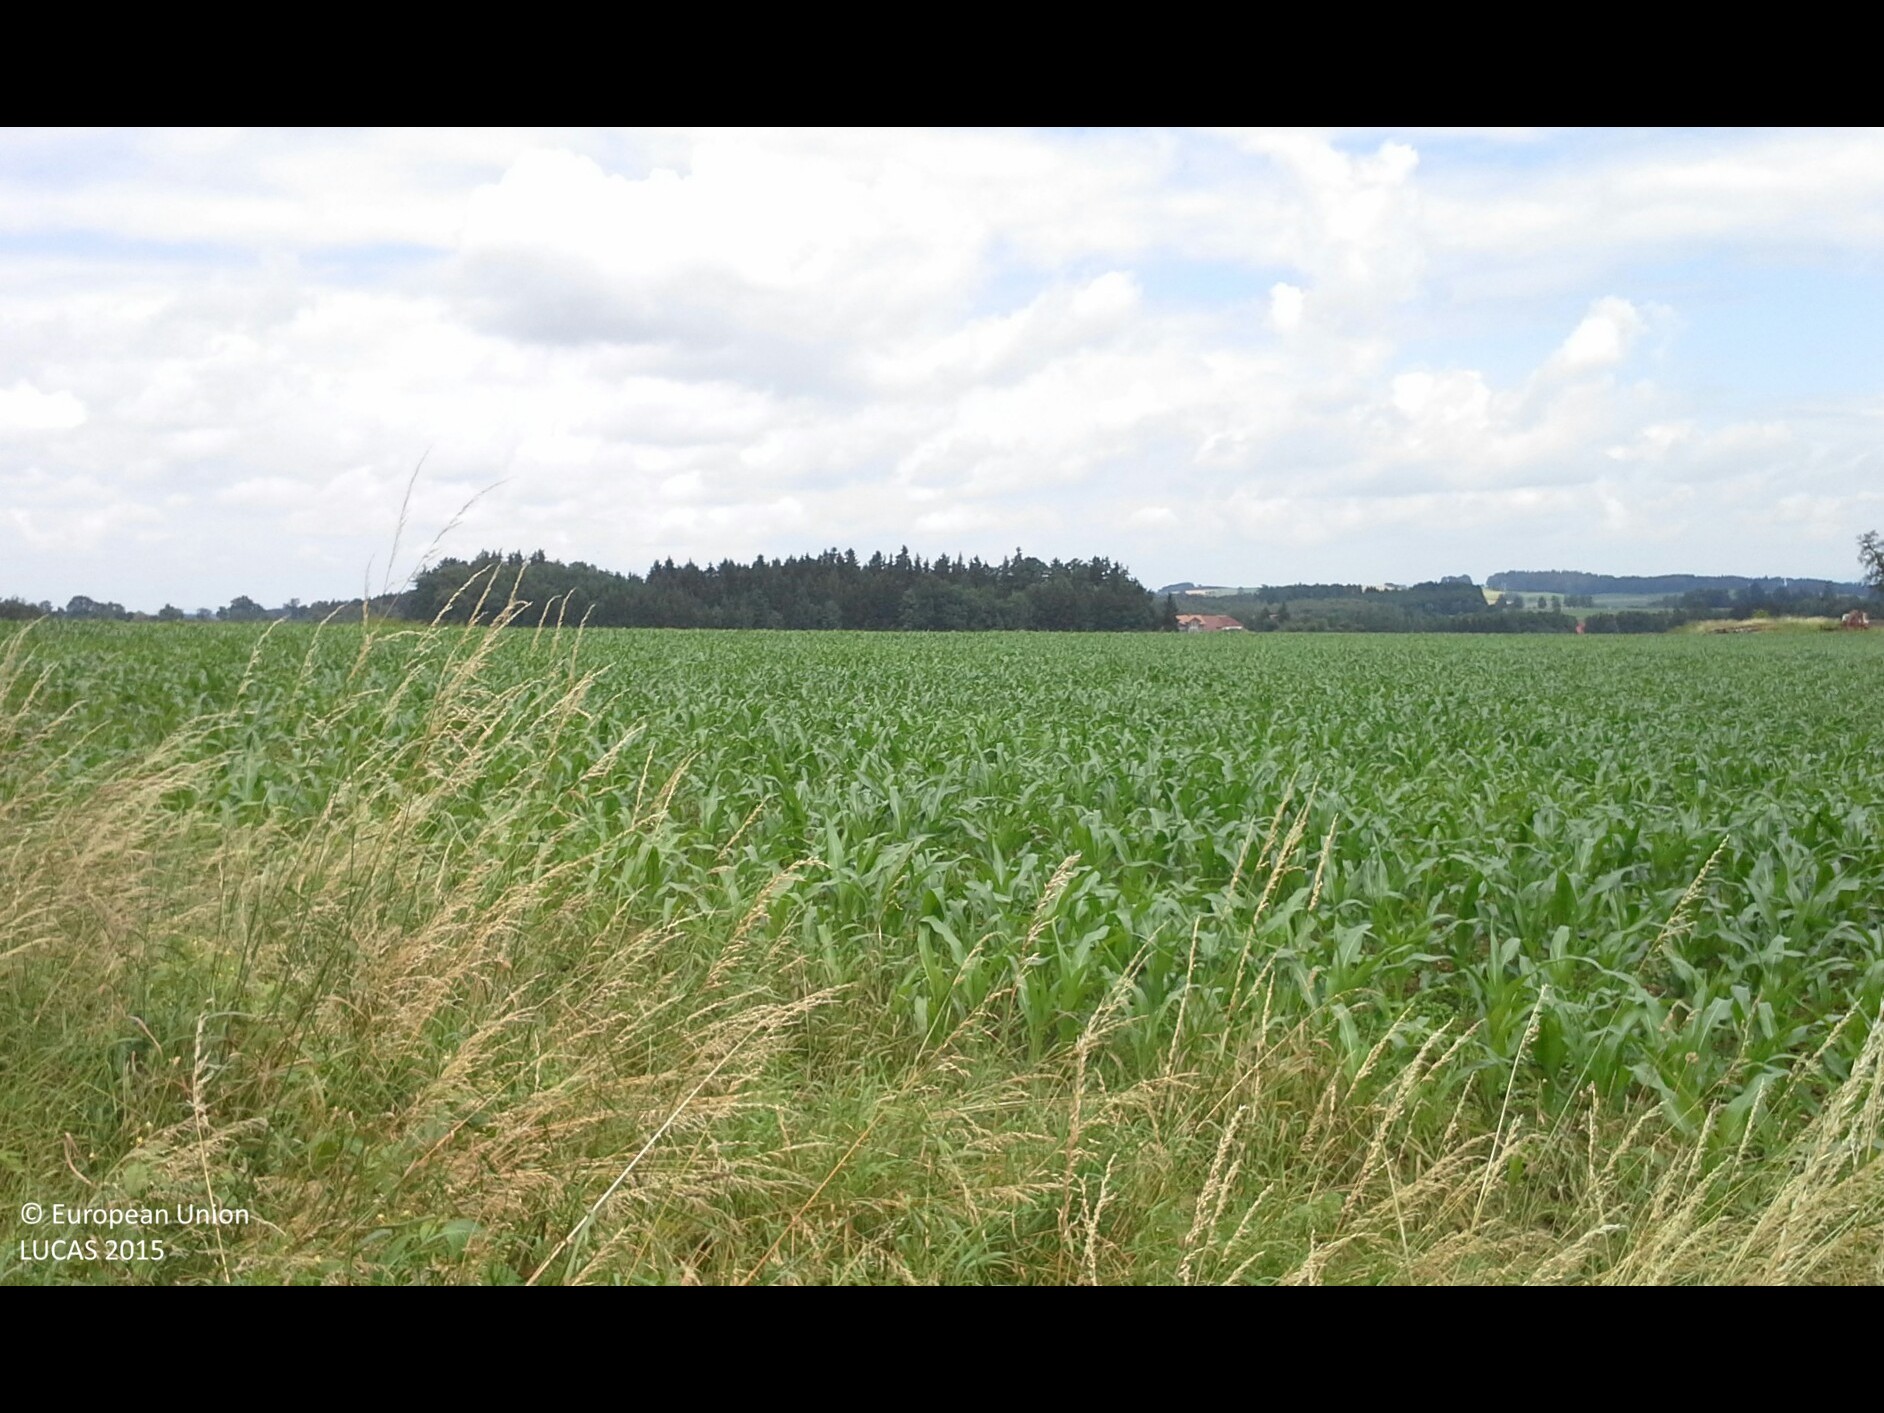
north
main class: Cropland
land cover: Common wheat
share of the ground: > 75 %
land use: Agriculture (excluding fallow land and kitchen gardens)
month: June
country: AT
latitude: 48.0374
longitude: 14.6006
